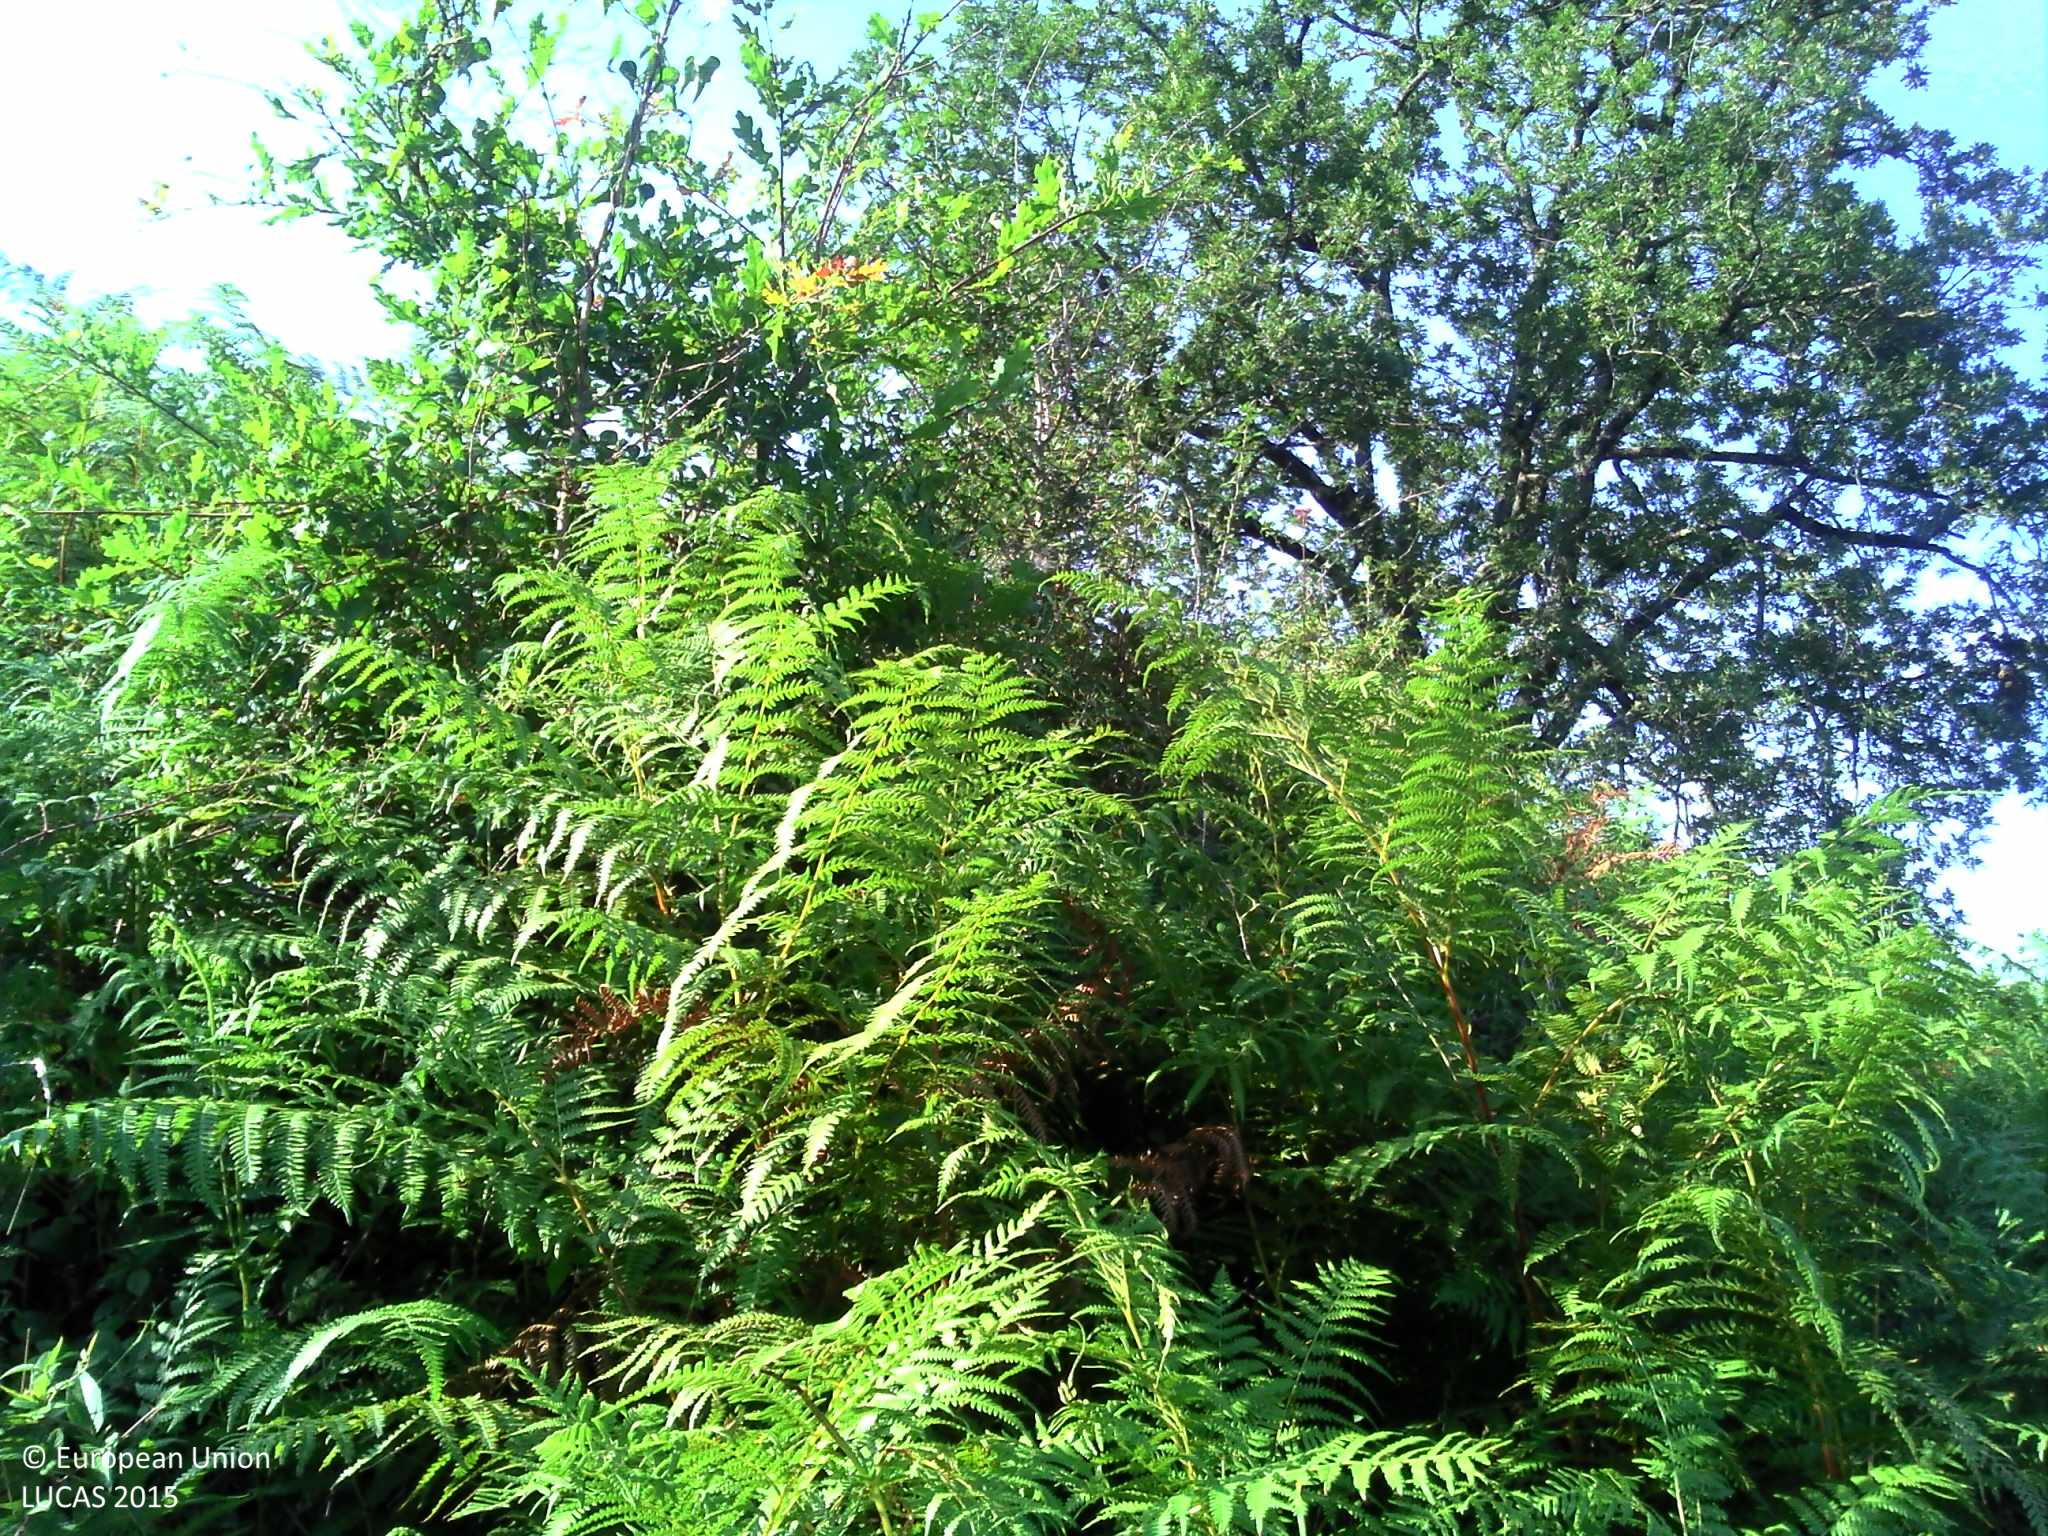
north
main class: Grassland
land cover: Grassland with sparse tree/shrub cover
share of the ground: > 75 %
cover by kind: herbaceous plants 85 %, shrubs 10 %, broadleaved forest trees 5 %
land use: Semi-natural and natural areas not in use
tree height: < 5 m
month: August
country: FR
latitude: 43.3567
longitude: -1.2303
